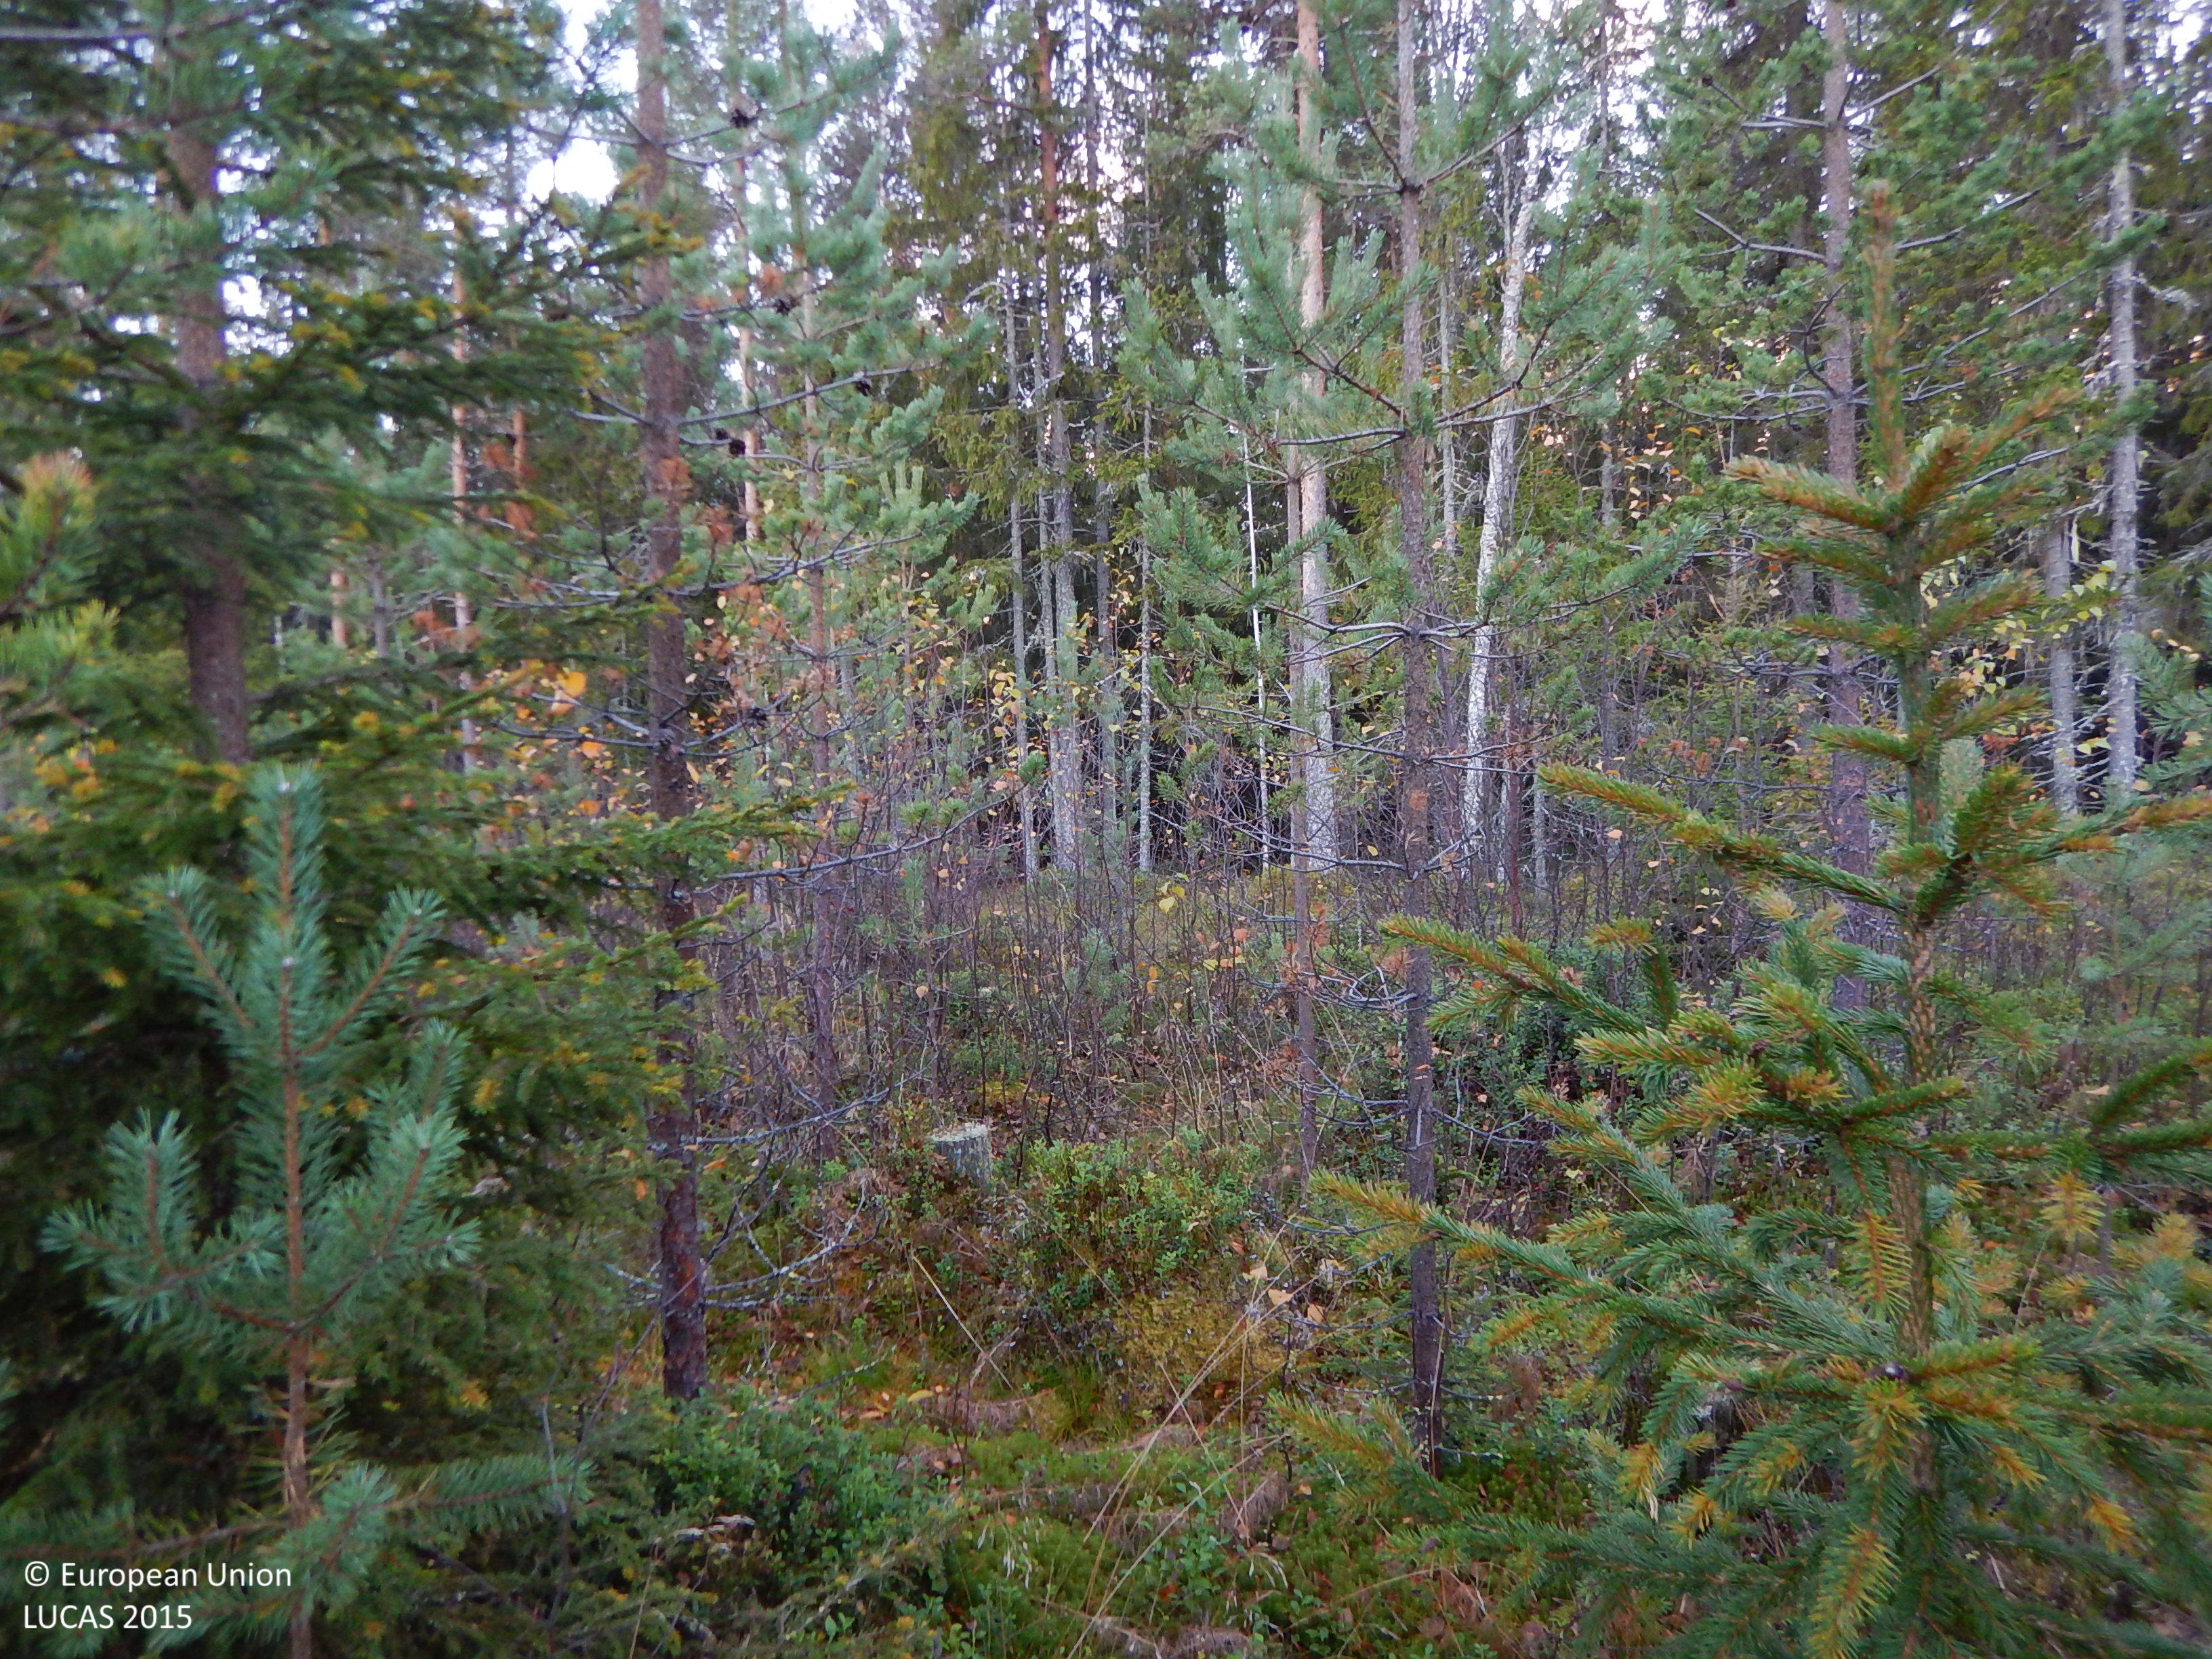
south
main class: Woodland
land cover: Pine dominated mixed woodland
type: boreal forest
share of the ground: 50 - 75 %
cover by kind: coniferous forest trees 50 %, broadleaved forest trees 20 %, shrubs 10 %, herbaceous plants 10 %, lichens and mosses 10 %
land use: Forestry
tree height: < 5 m
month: October
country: SE
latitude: 64.9466
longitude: 21.0030
